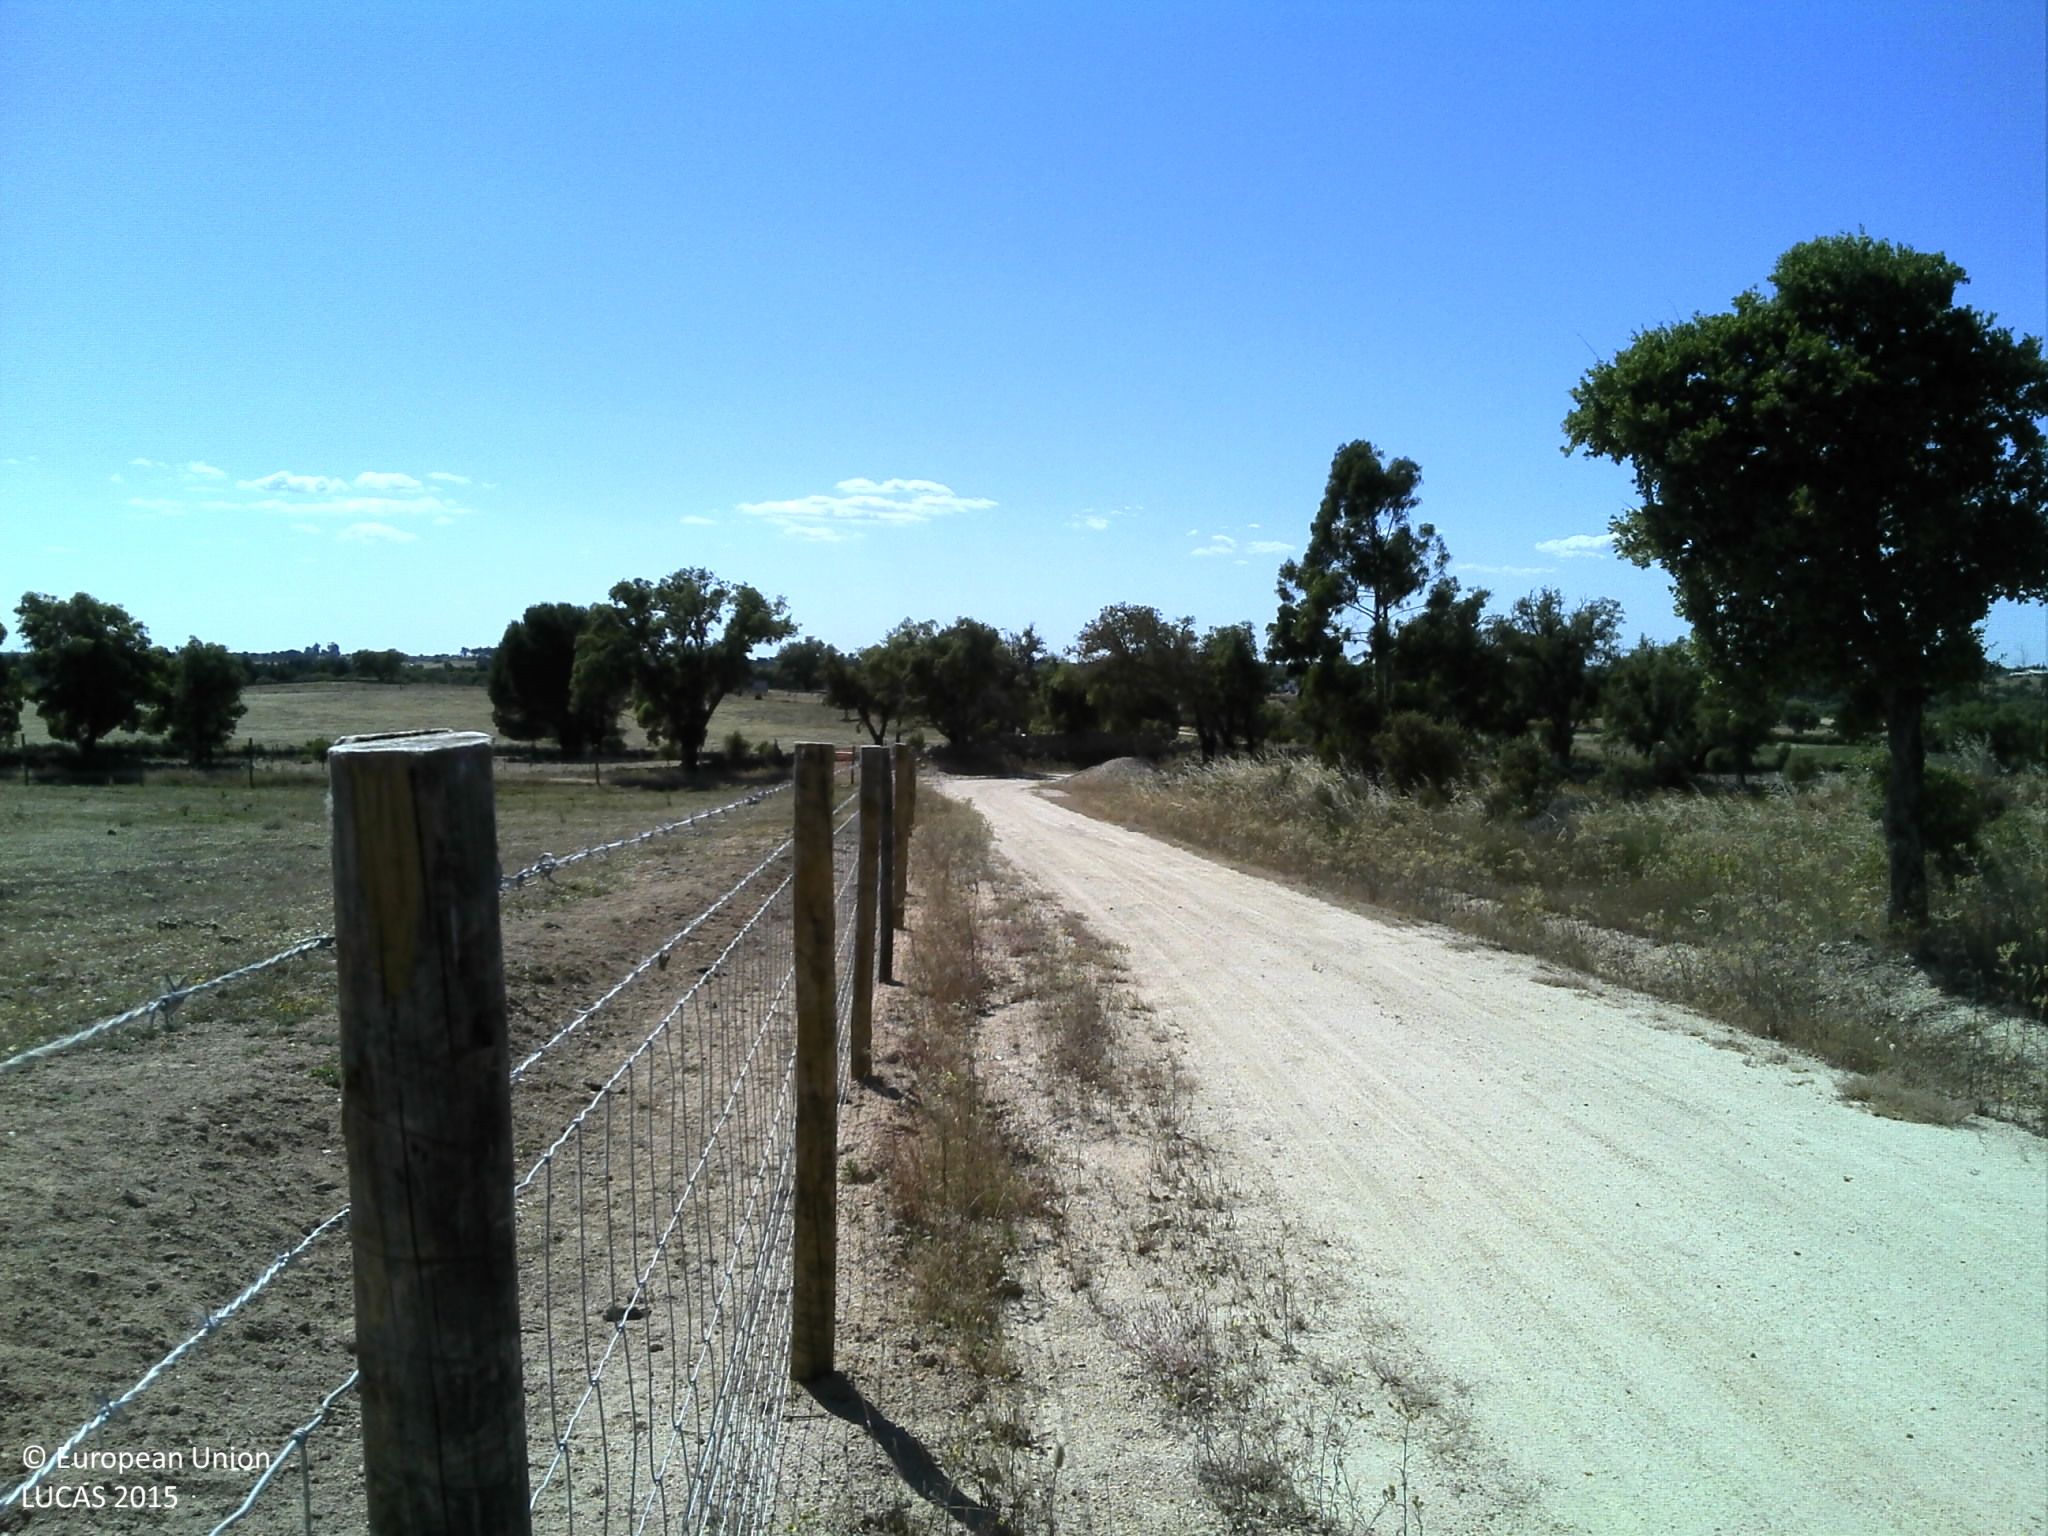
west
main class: Grassland
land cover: Grassland without tree/shrub cover
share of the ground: 25 - 50 %
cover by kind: herbaceous plants 50 %, unconsolidated bare surface 50 %
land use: Agriculture (excluding fallow land and kitchen gardens)
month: May
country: PT
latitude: 39.4027
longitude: -7.6895
